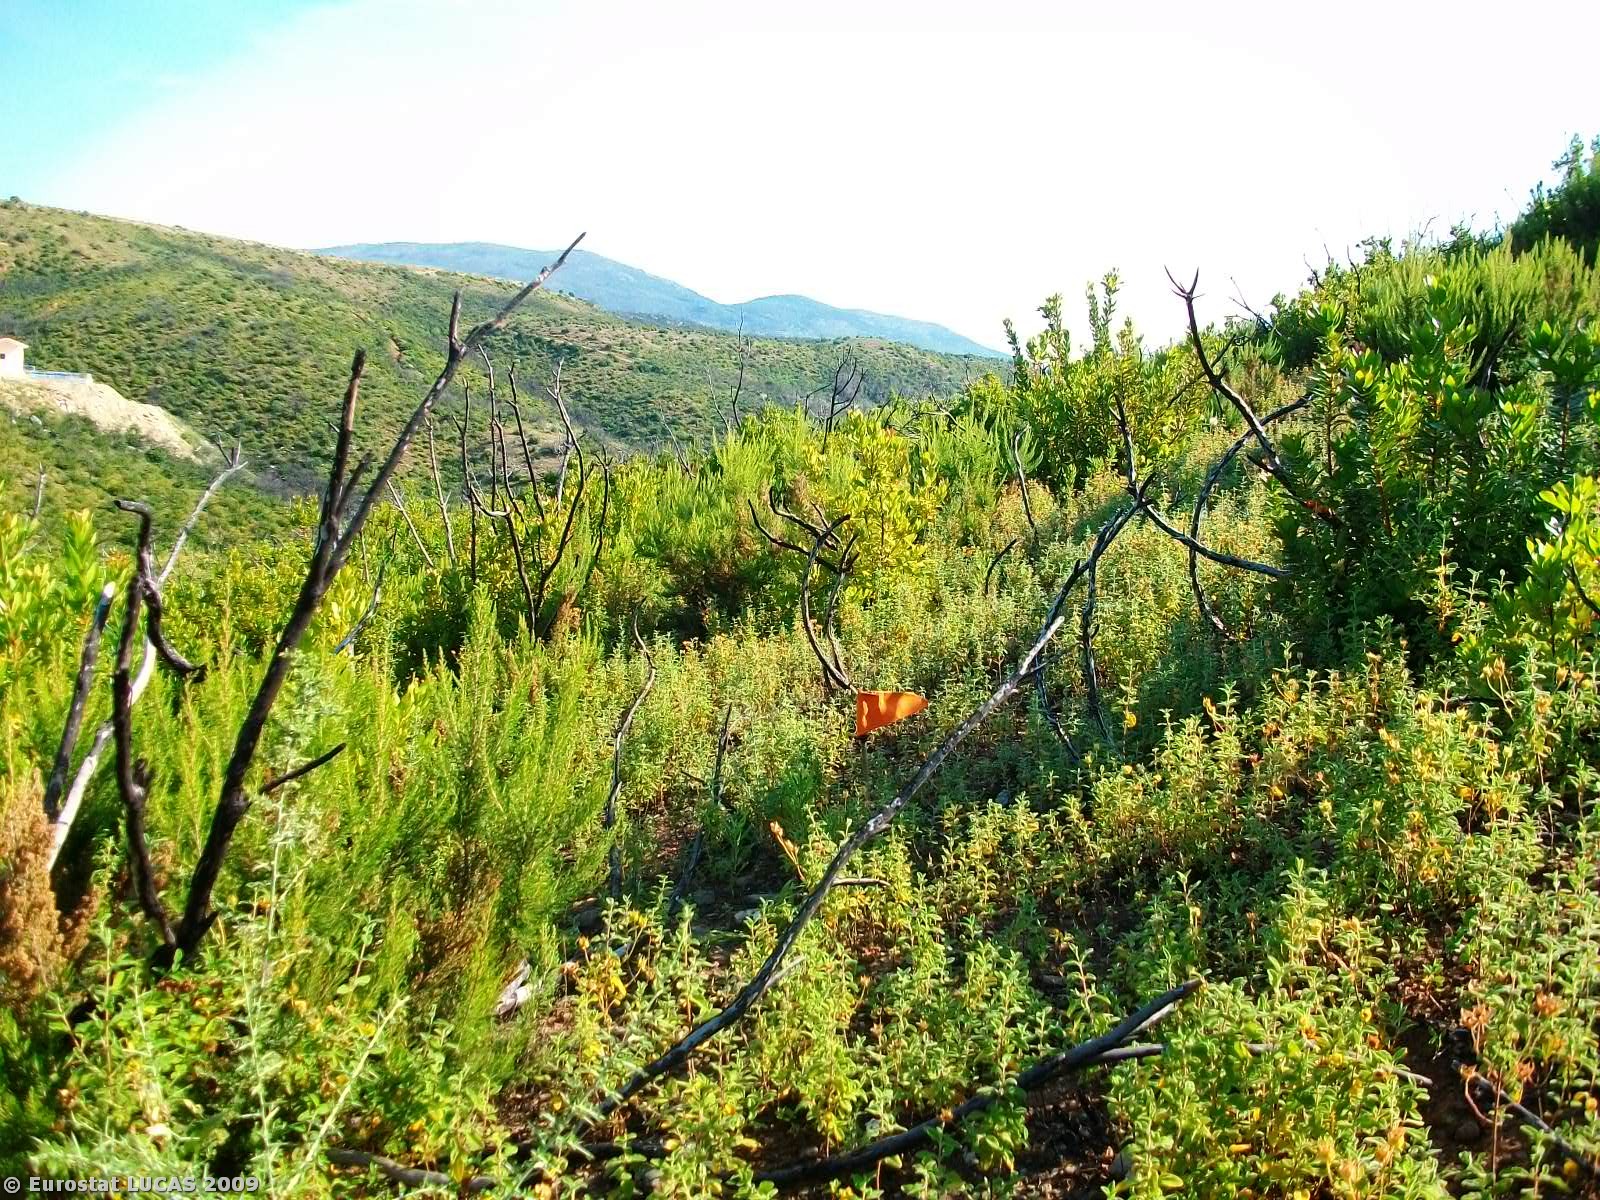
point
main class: Shrubland
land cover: Shrubland without tree cover
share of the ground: > 75 %
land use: Unused
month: June
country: GR
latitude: 39.2559
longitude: 23.2389
